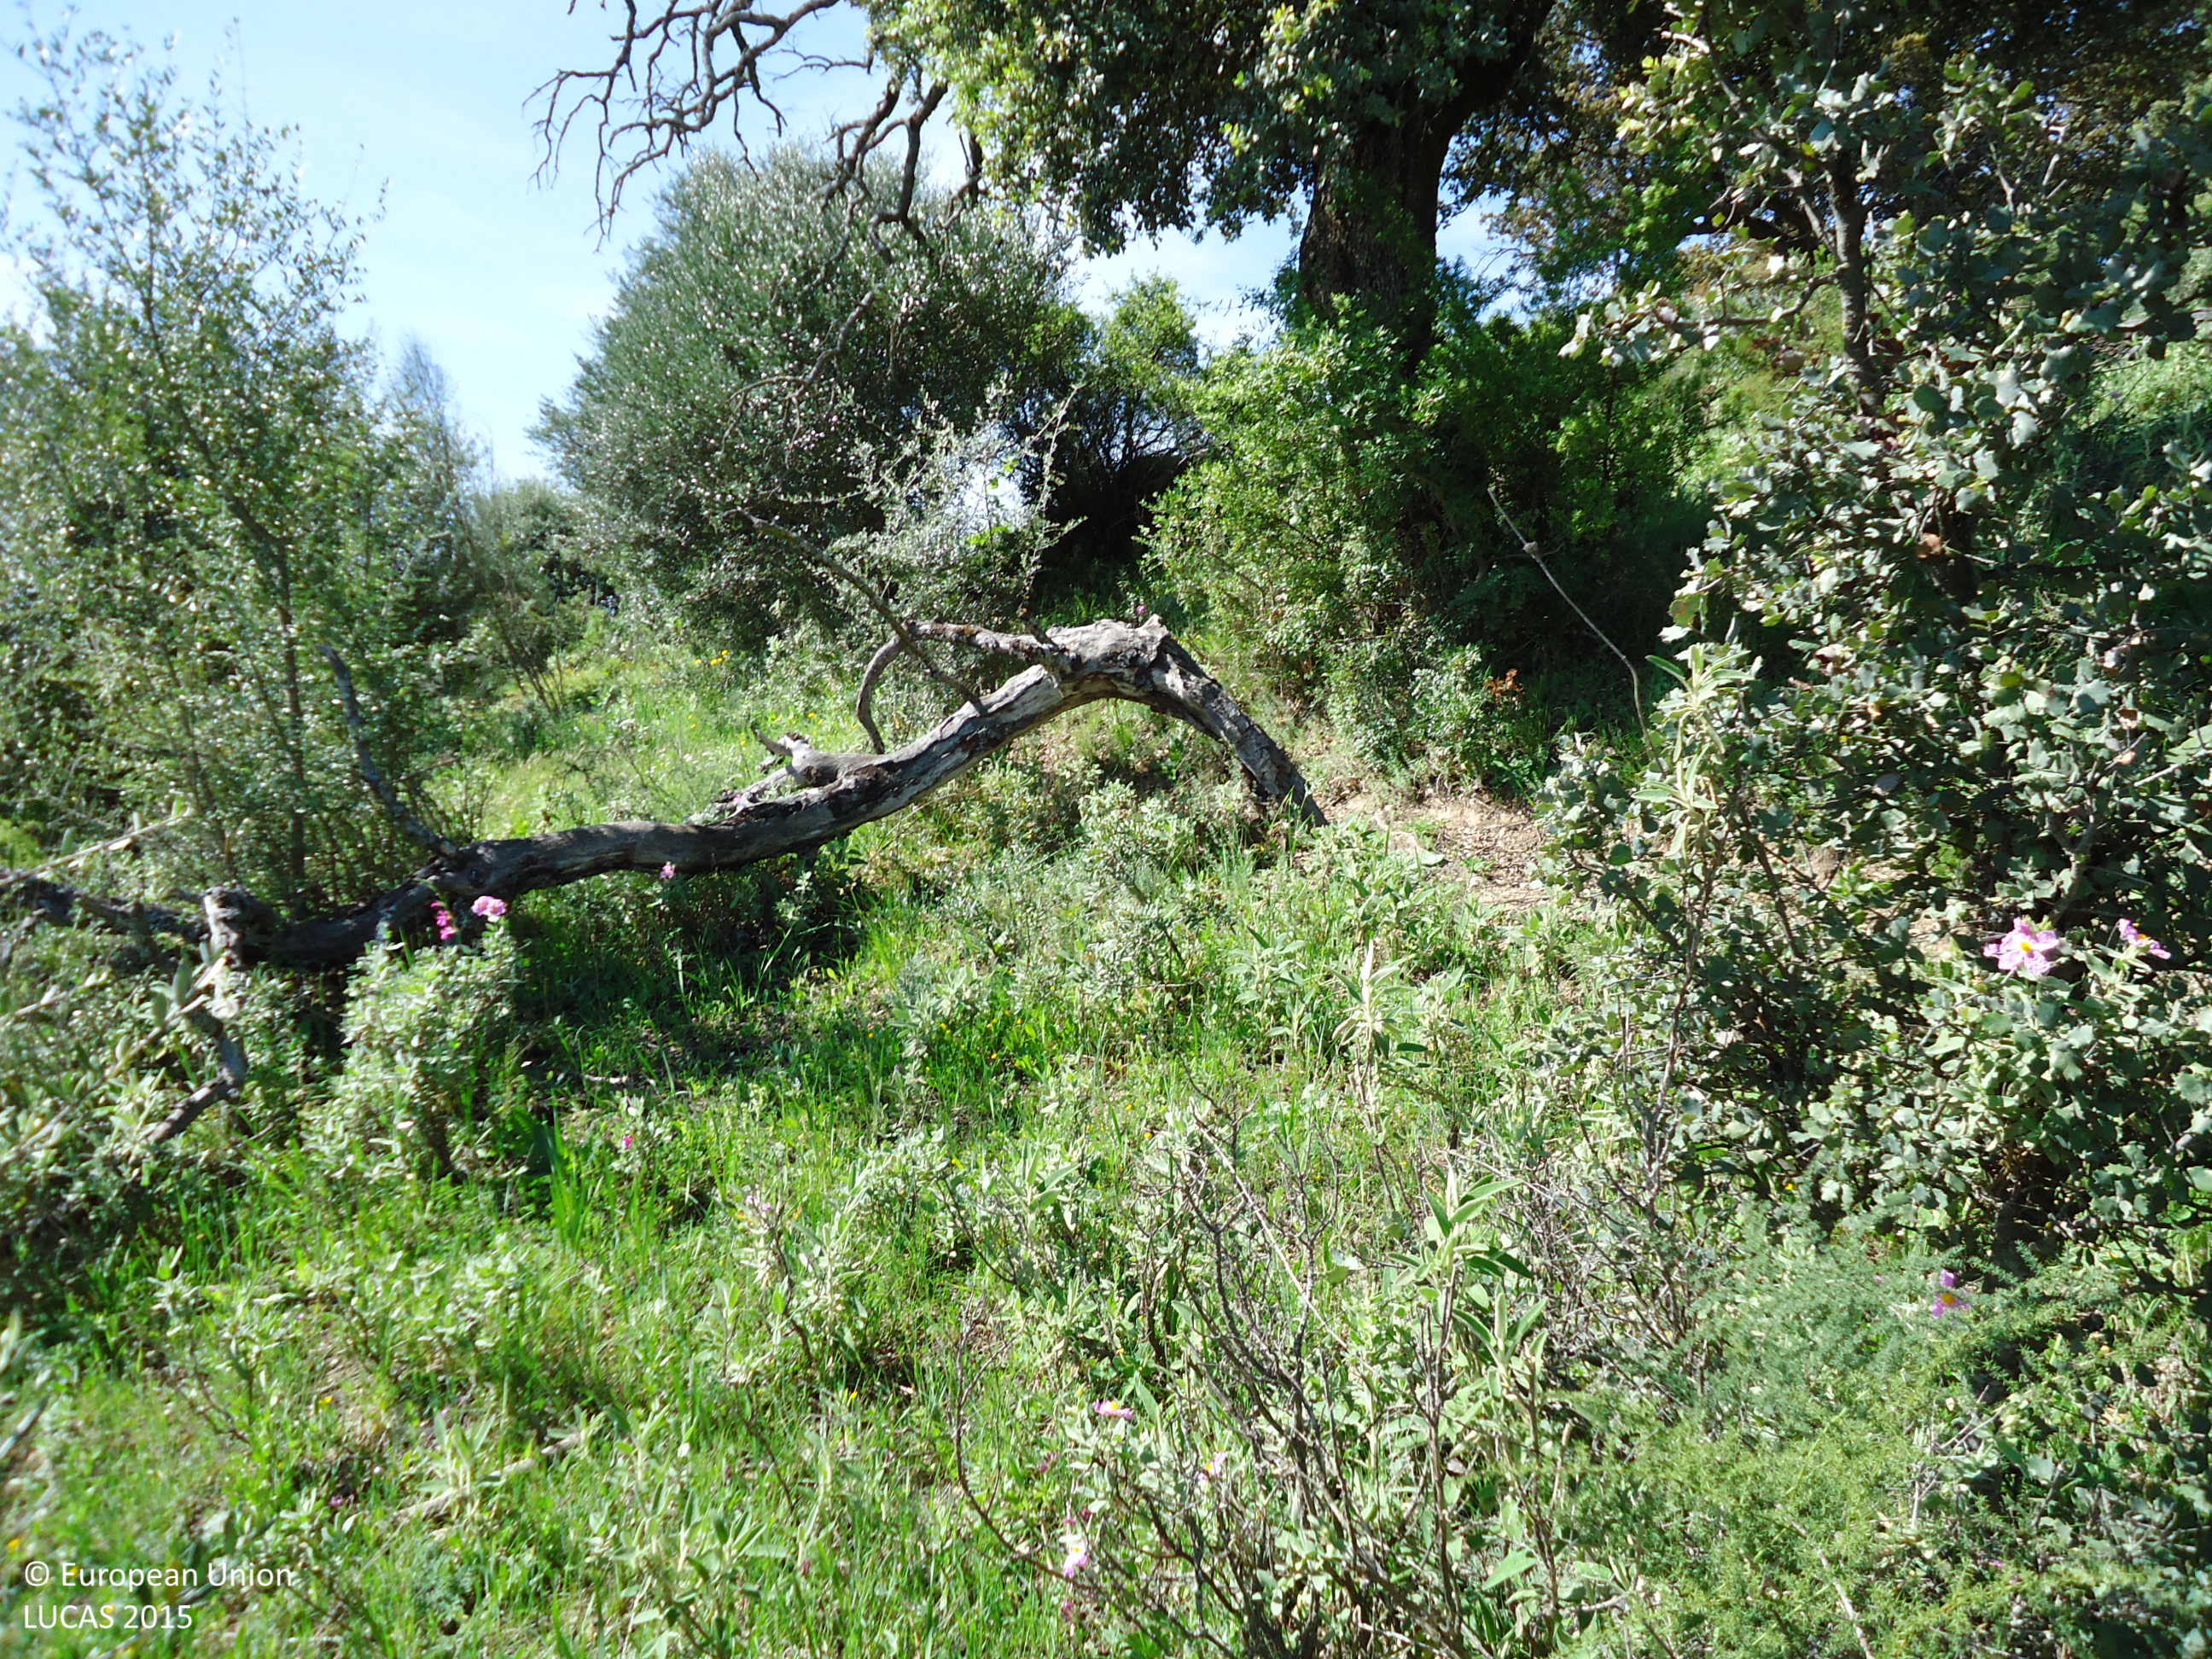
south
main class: Shrubland
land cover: Shrubland with sparse tree cover
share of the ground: 50 - 75 %
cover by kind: shrubs 70 %, herbaceous plants 25 %, broadleaved forest trees 5 %
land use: Agriculture (excluding fallow land and kitchen gardens)
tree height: > 5 m
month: April
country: ES
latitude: 36.9348
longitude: -5.3533
